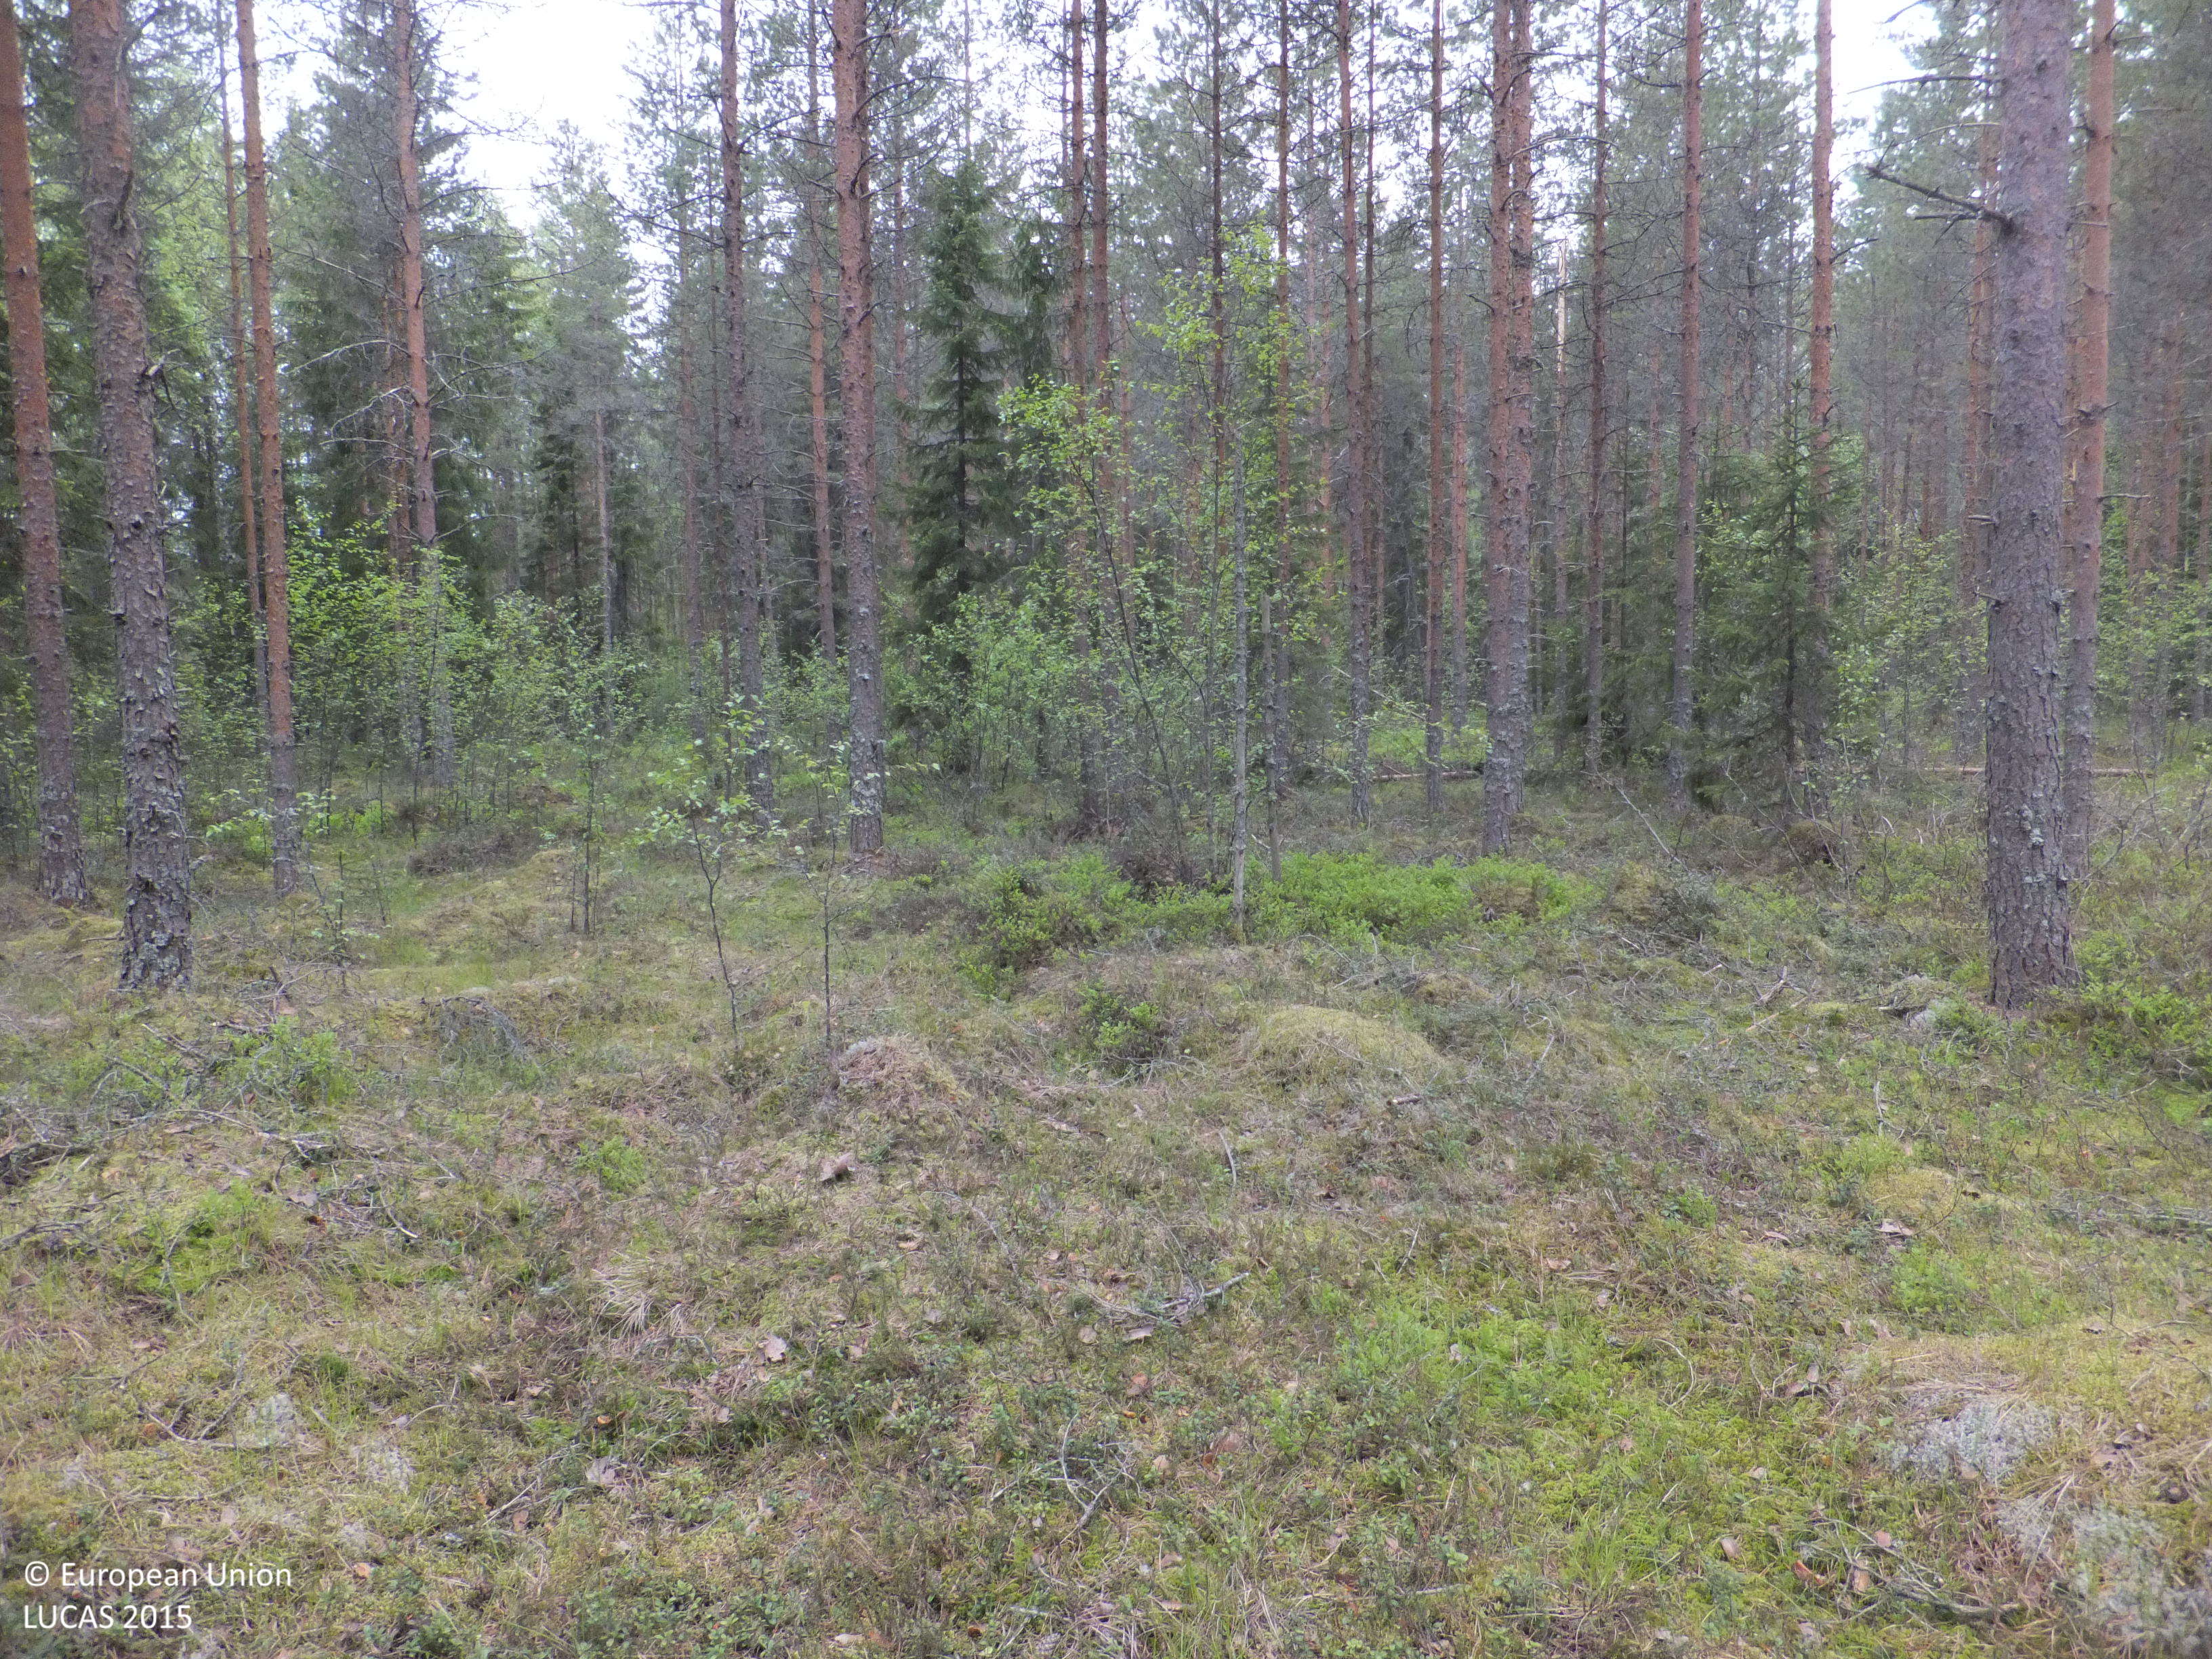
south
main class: Woodland
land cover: Pine dominated coniferous woodland
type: hemiboreal forest and nemoral coniferous forest and mixed broadleaved-coniferous forest
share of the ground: > 75 %
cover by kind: coniferous forest trees 80 %, shrubs 15 %, lichens and mosses 5 %
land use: Forestry
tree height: > 5 m
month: June
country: FI
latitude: 63.4920
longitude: 22.8037
